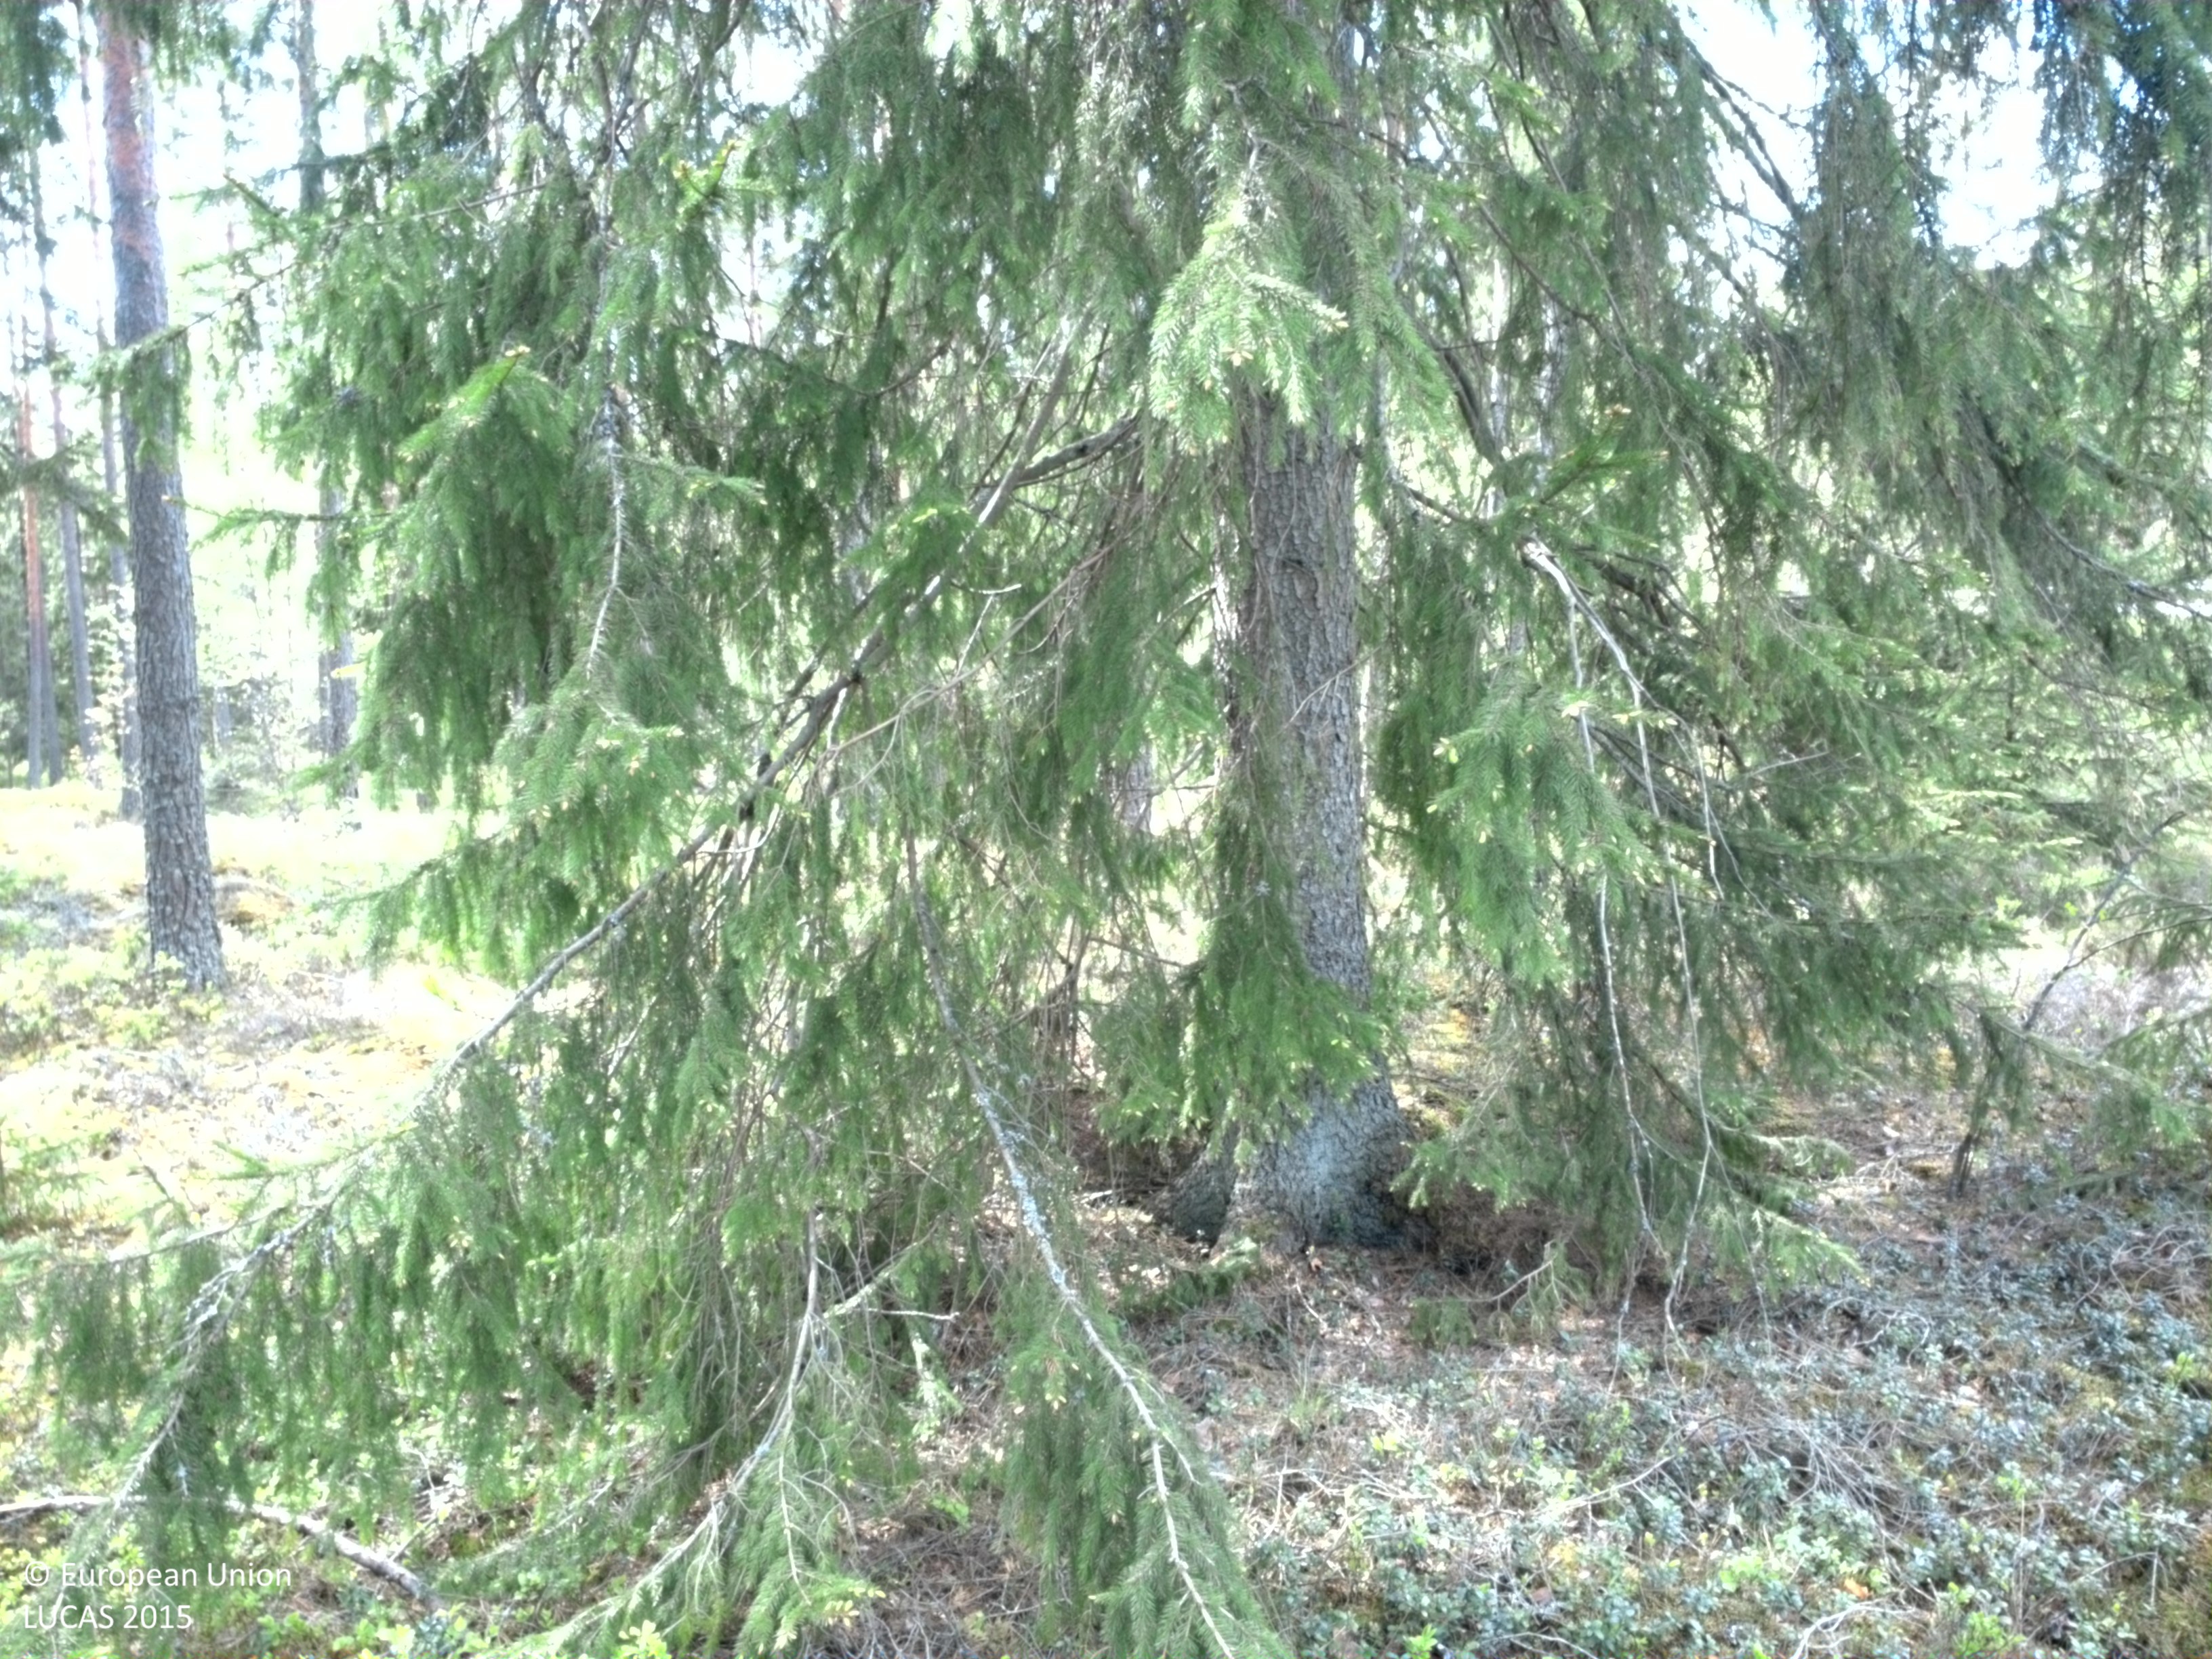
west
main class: Woodland
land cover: Pine dominated coniferous woodland
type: boreal forest
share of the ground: 50 - 75 %
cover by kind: coniferous forest trees 55 %, shrubs 20 %, broadleaved forest trees 10 %, lichens and mosses 10 %, herbaceous plants 5 %
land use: Forestry
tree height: > 5 m
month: May
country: SE
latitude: 56.7857
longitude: 15.1867
